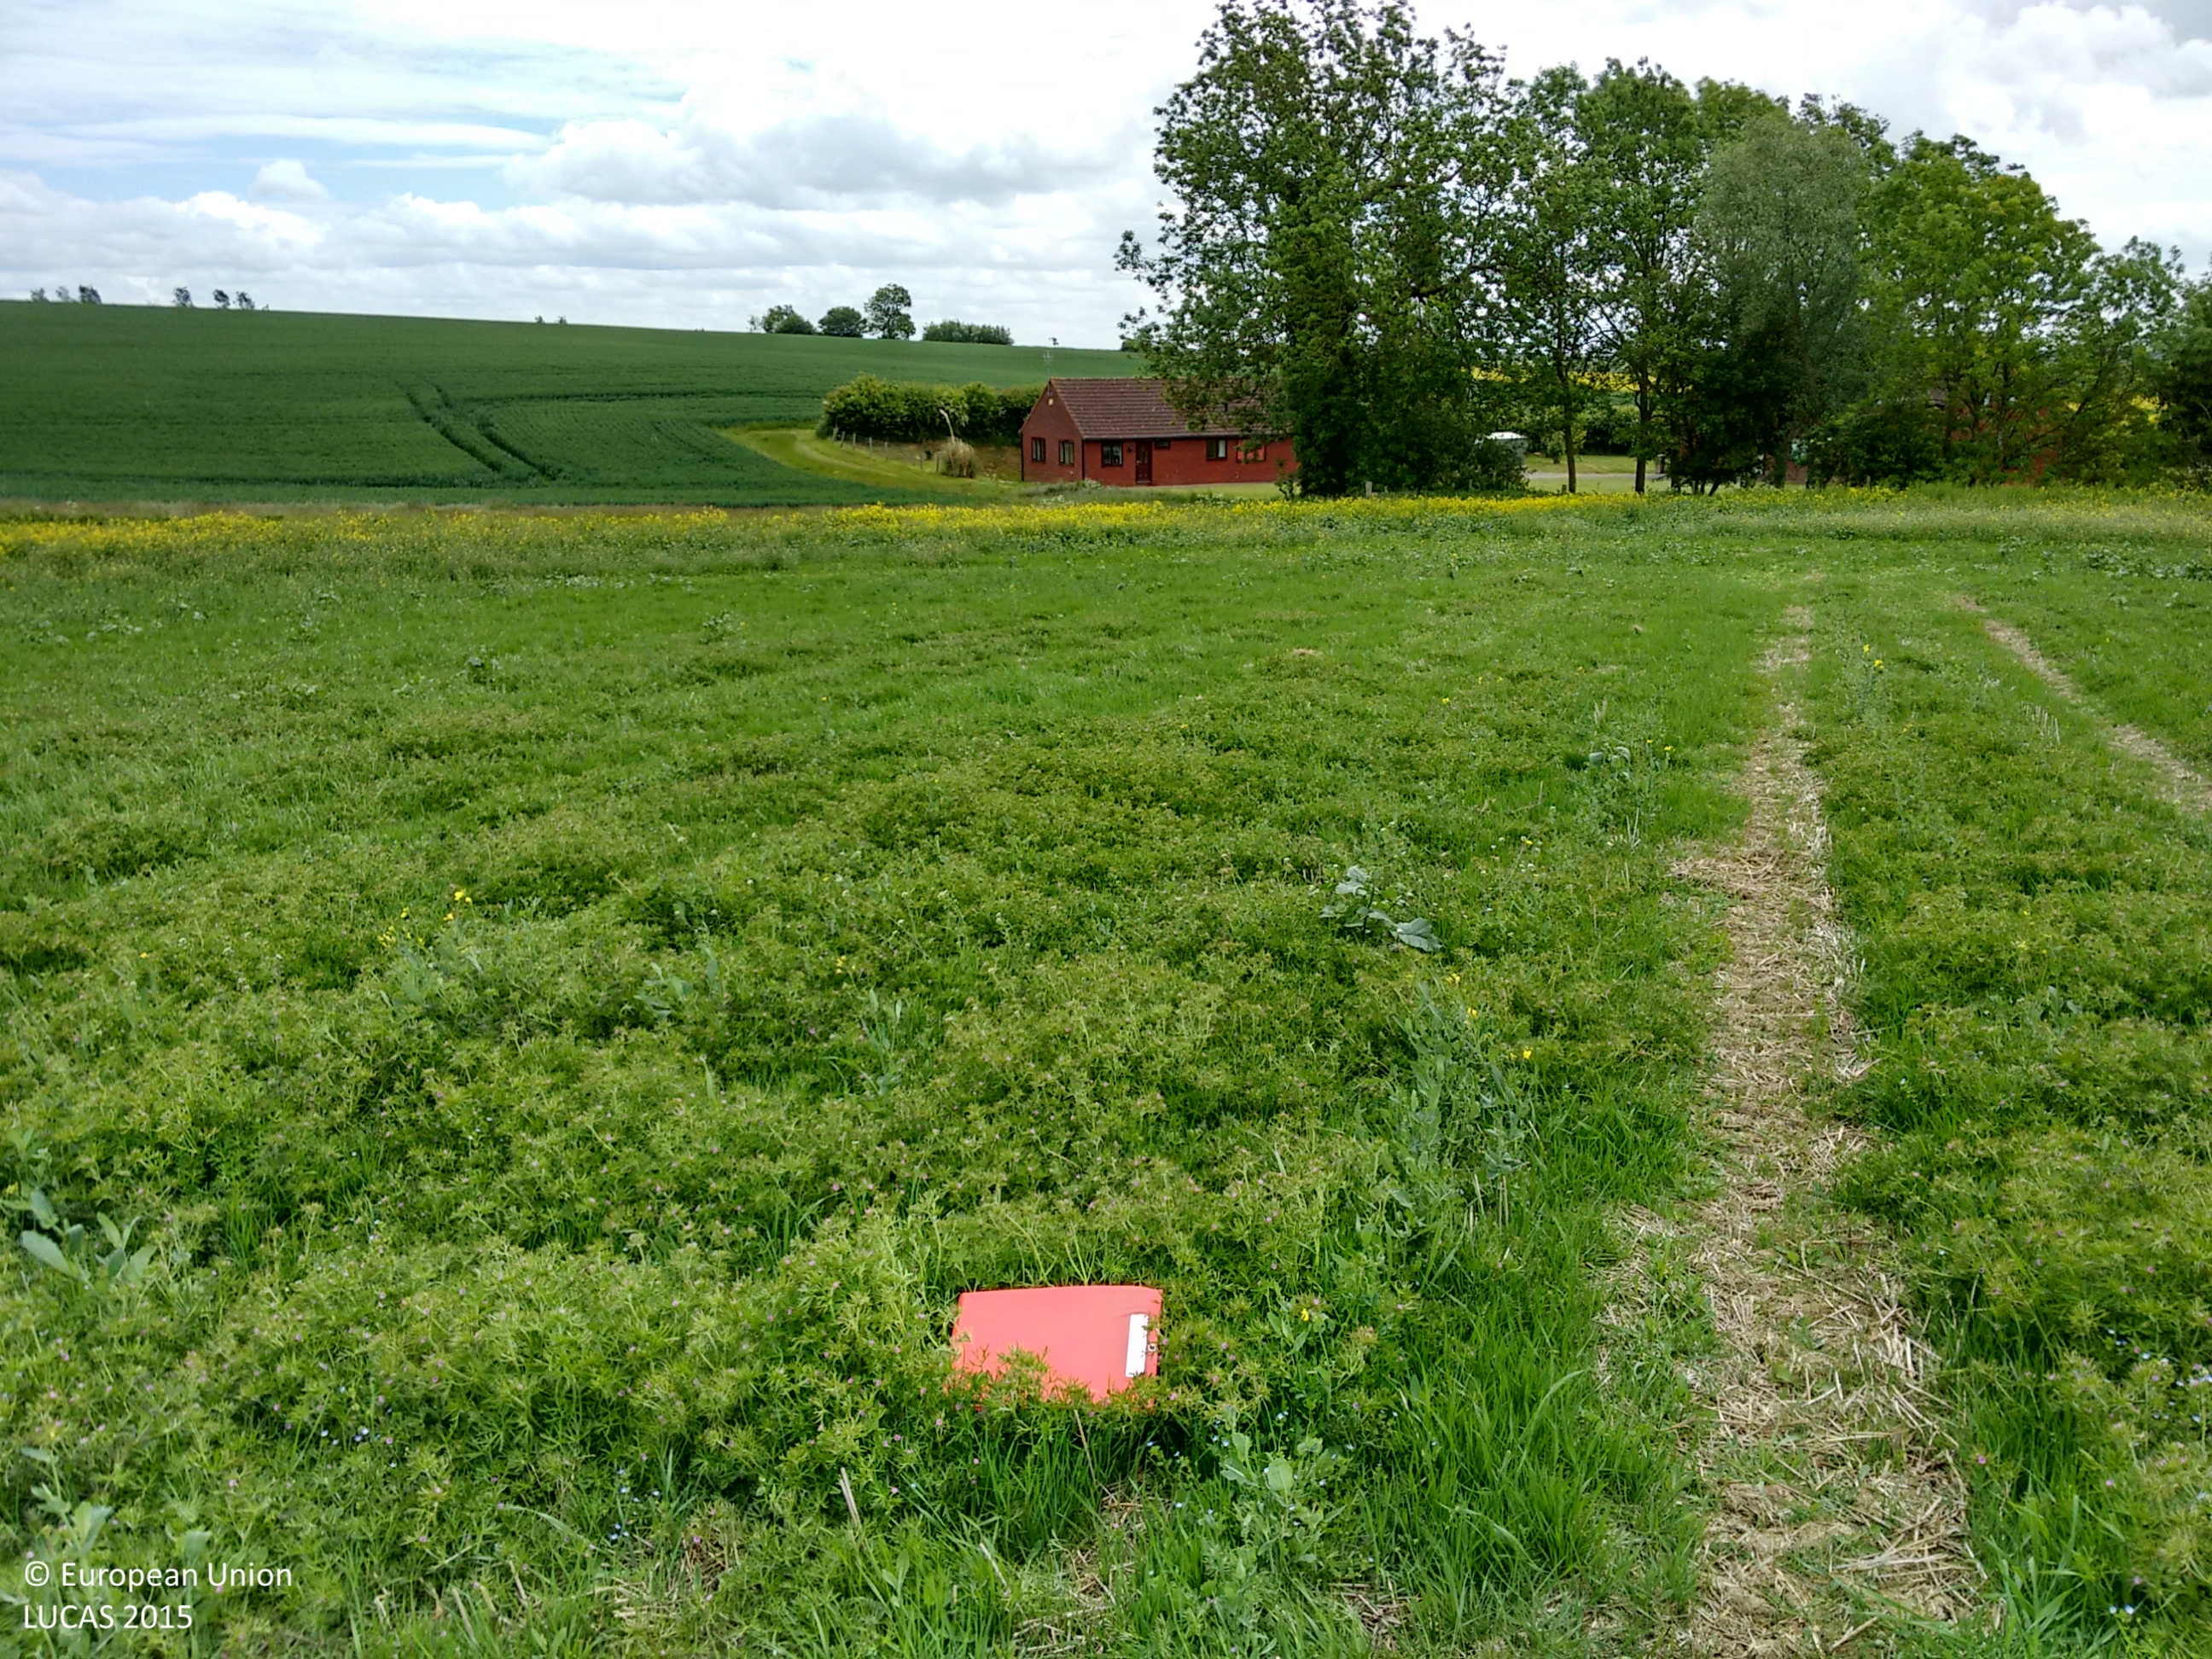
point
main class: Grassland
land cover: Spontaneously vegetated surfaces
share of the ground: > 75 %
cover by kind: herbaceous plants 100 %
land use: Fallow land
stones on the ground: < 10 %
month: June
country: GB
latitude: 52.2362
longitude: -0.5082
